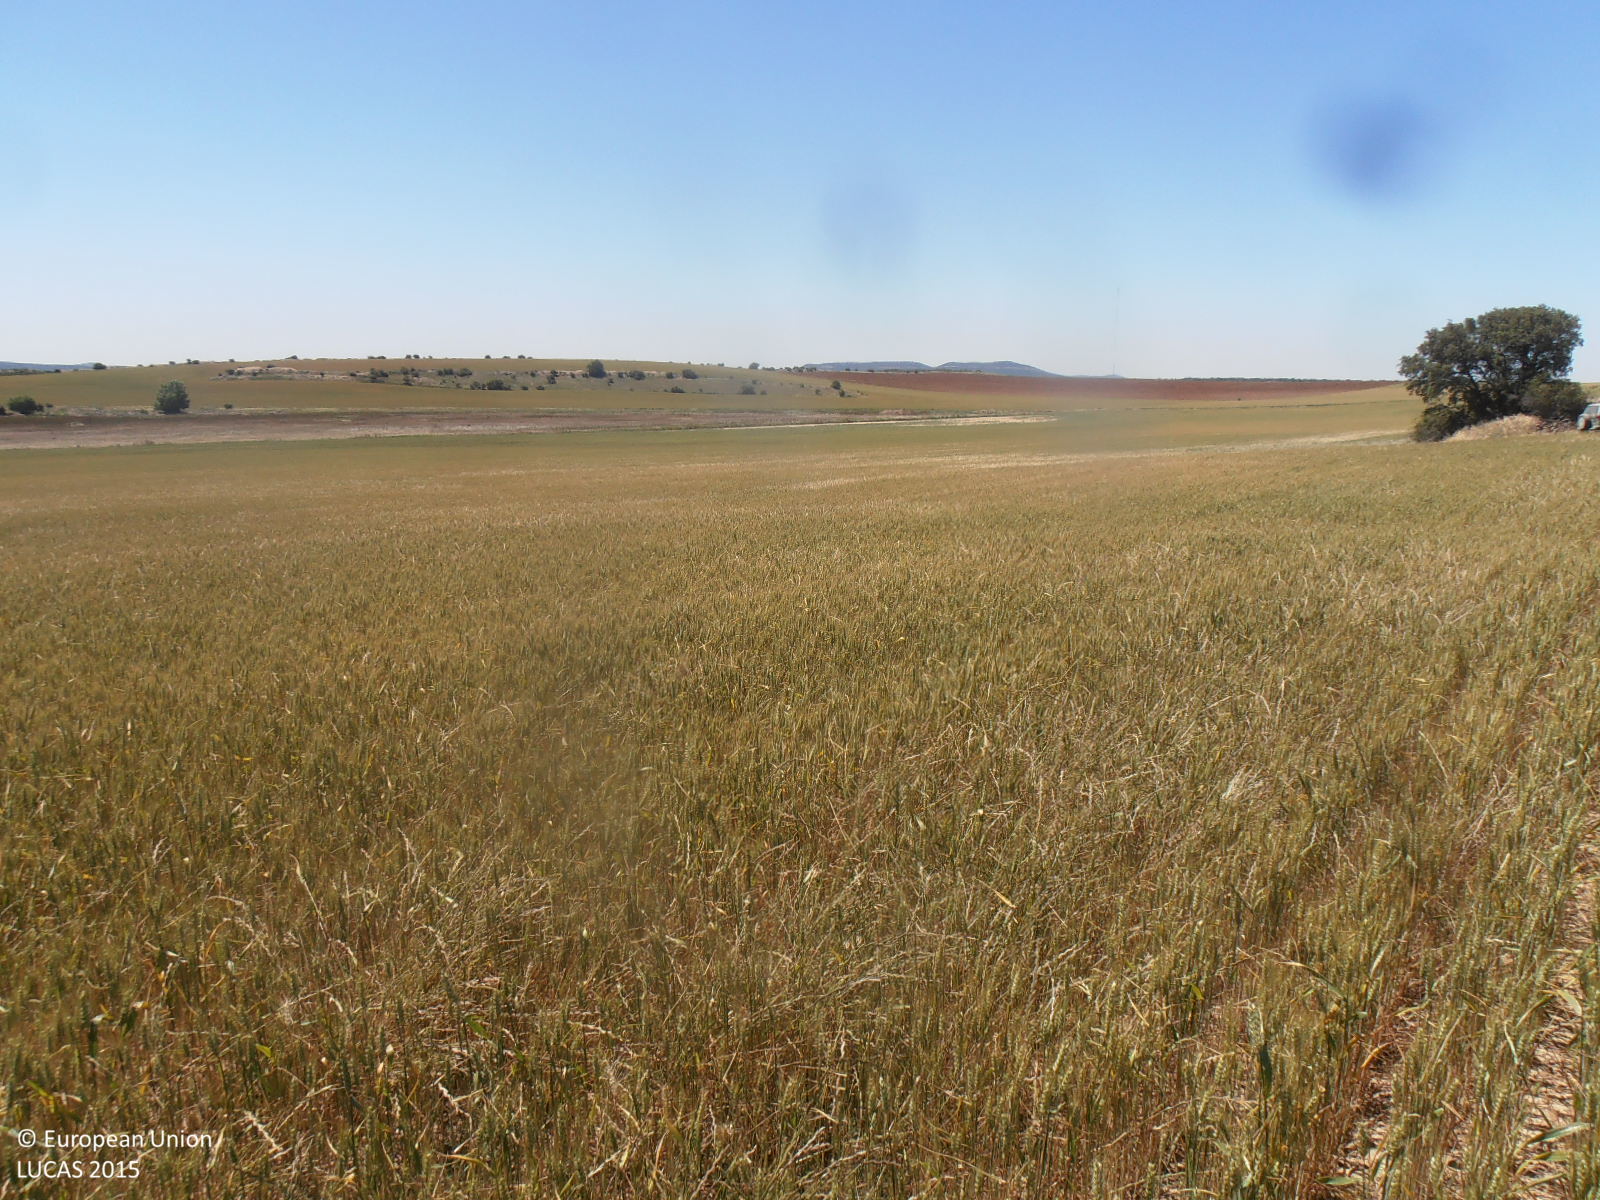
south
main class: Cropland
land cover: Common wheat
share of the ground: > 75 %
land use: Agriculture (excluding fallow land and kitchen gardens)
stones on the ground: 10 - 25 %
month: June
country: ES
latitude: 41.6871
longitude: -1.9617
